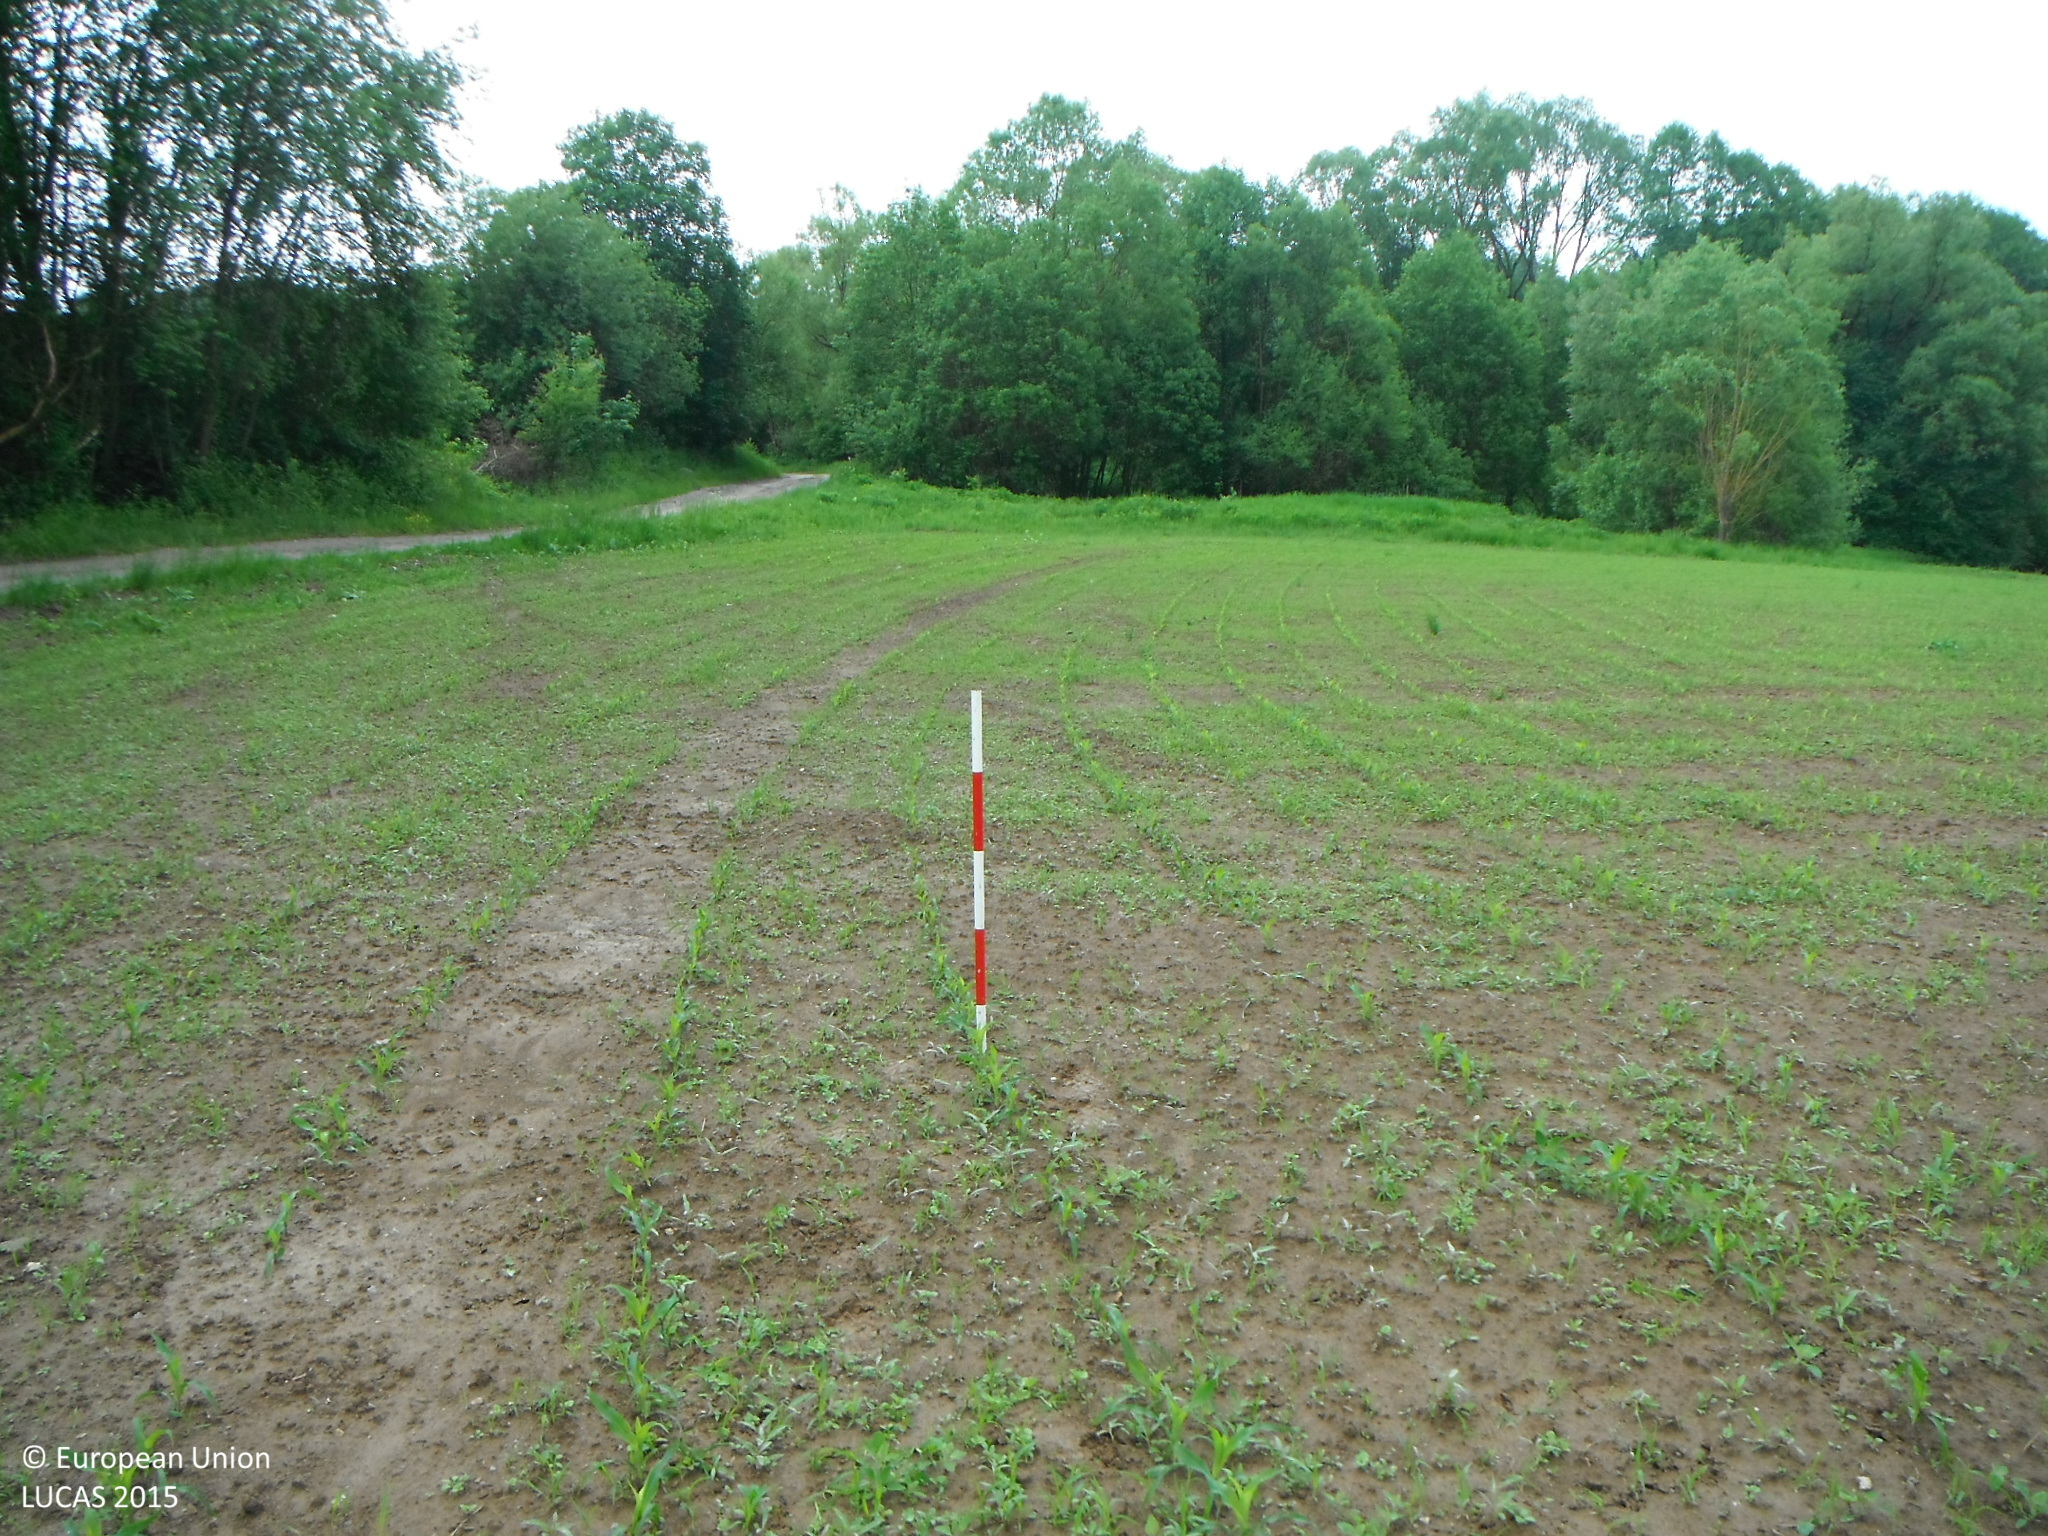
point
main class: Cropland
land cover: Maize
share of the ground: < 10 %
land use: Agriculture (excluding fallow land and kitchen gardens)
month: May
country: SK
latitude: 48.7411
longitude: 19.2291
